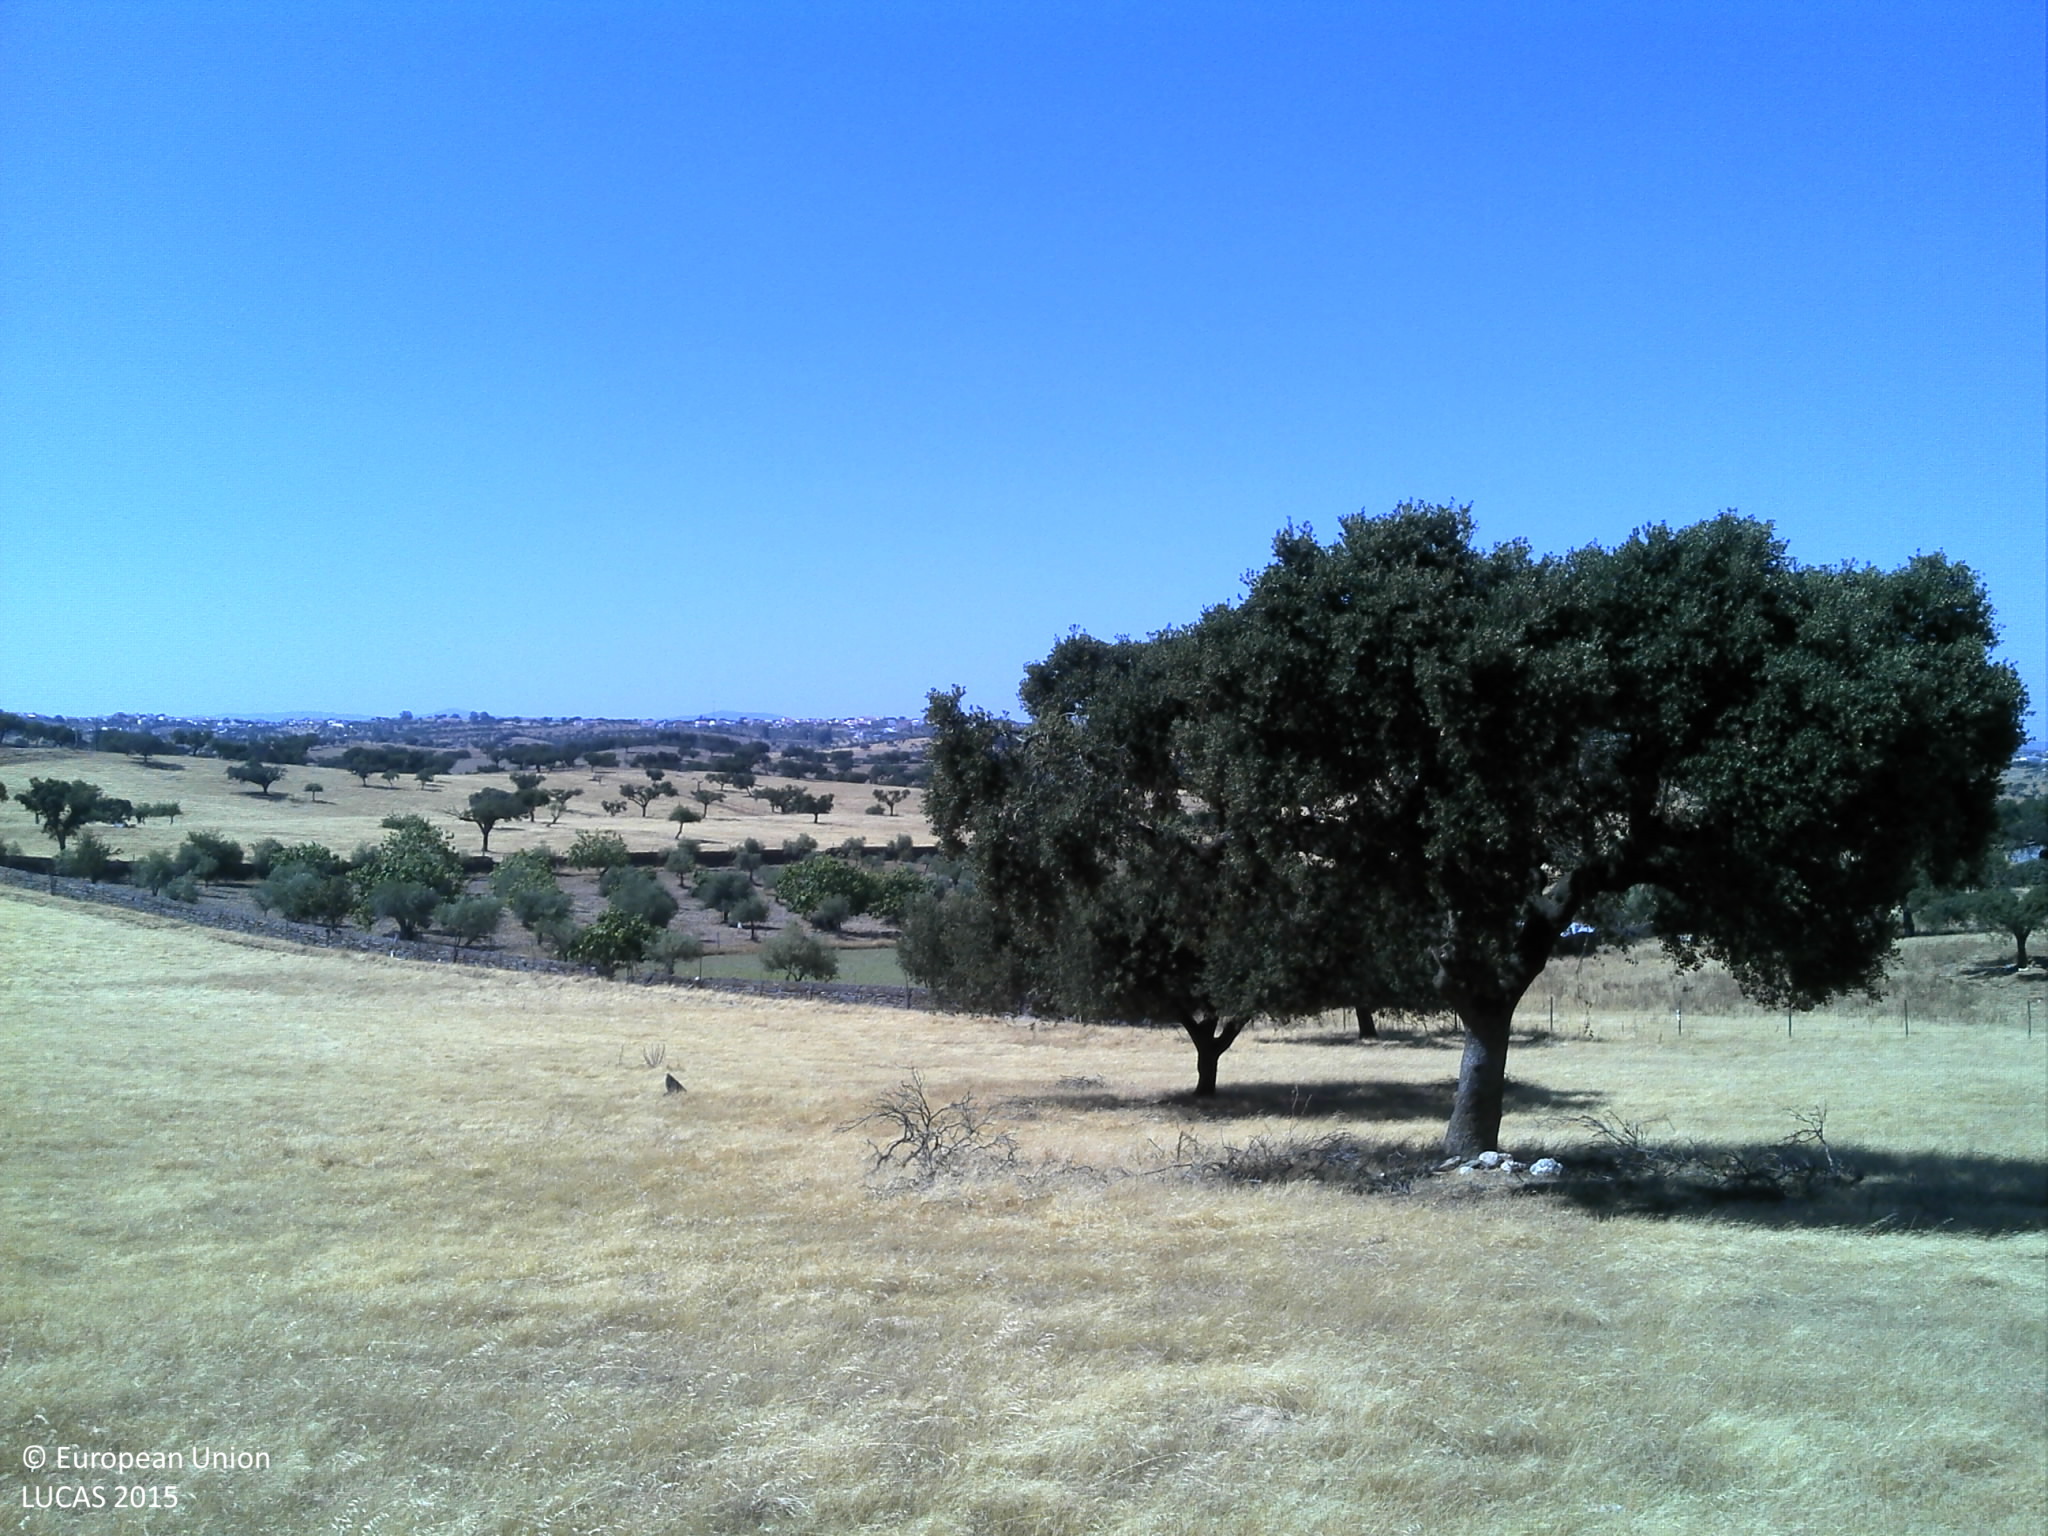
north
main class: Woodland
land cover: Broadleaved woodland
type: broadleaved evergreen forest
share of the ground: 25 - 50 %
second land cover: Grassland without tree/shrub cover
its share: 50 - 75 %
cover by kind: herbaceous plants 50 %, broadleaved forest trees 25 %, unconsolidated bare surface 25 %
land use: Forestry
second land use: Agriculture (excluding fallow land and kitchen gardens)
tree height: > 5 m
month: July
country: PT
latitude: 38.5193
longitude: -7.4733
